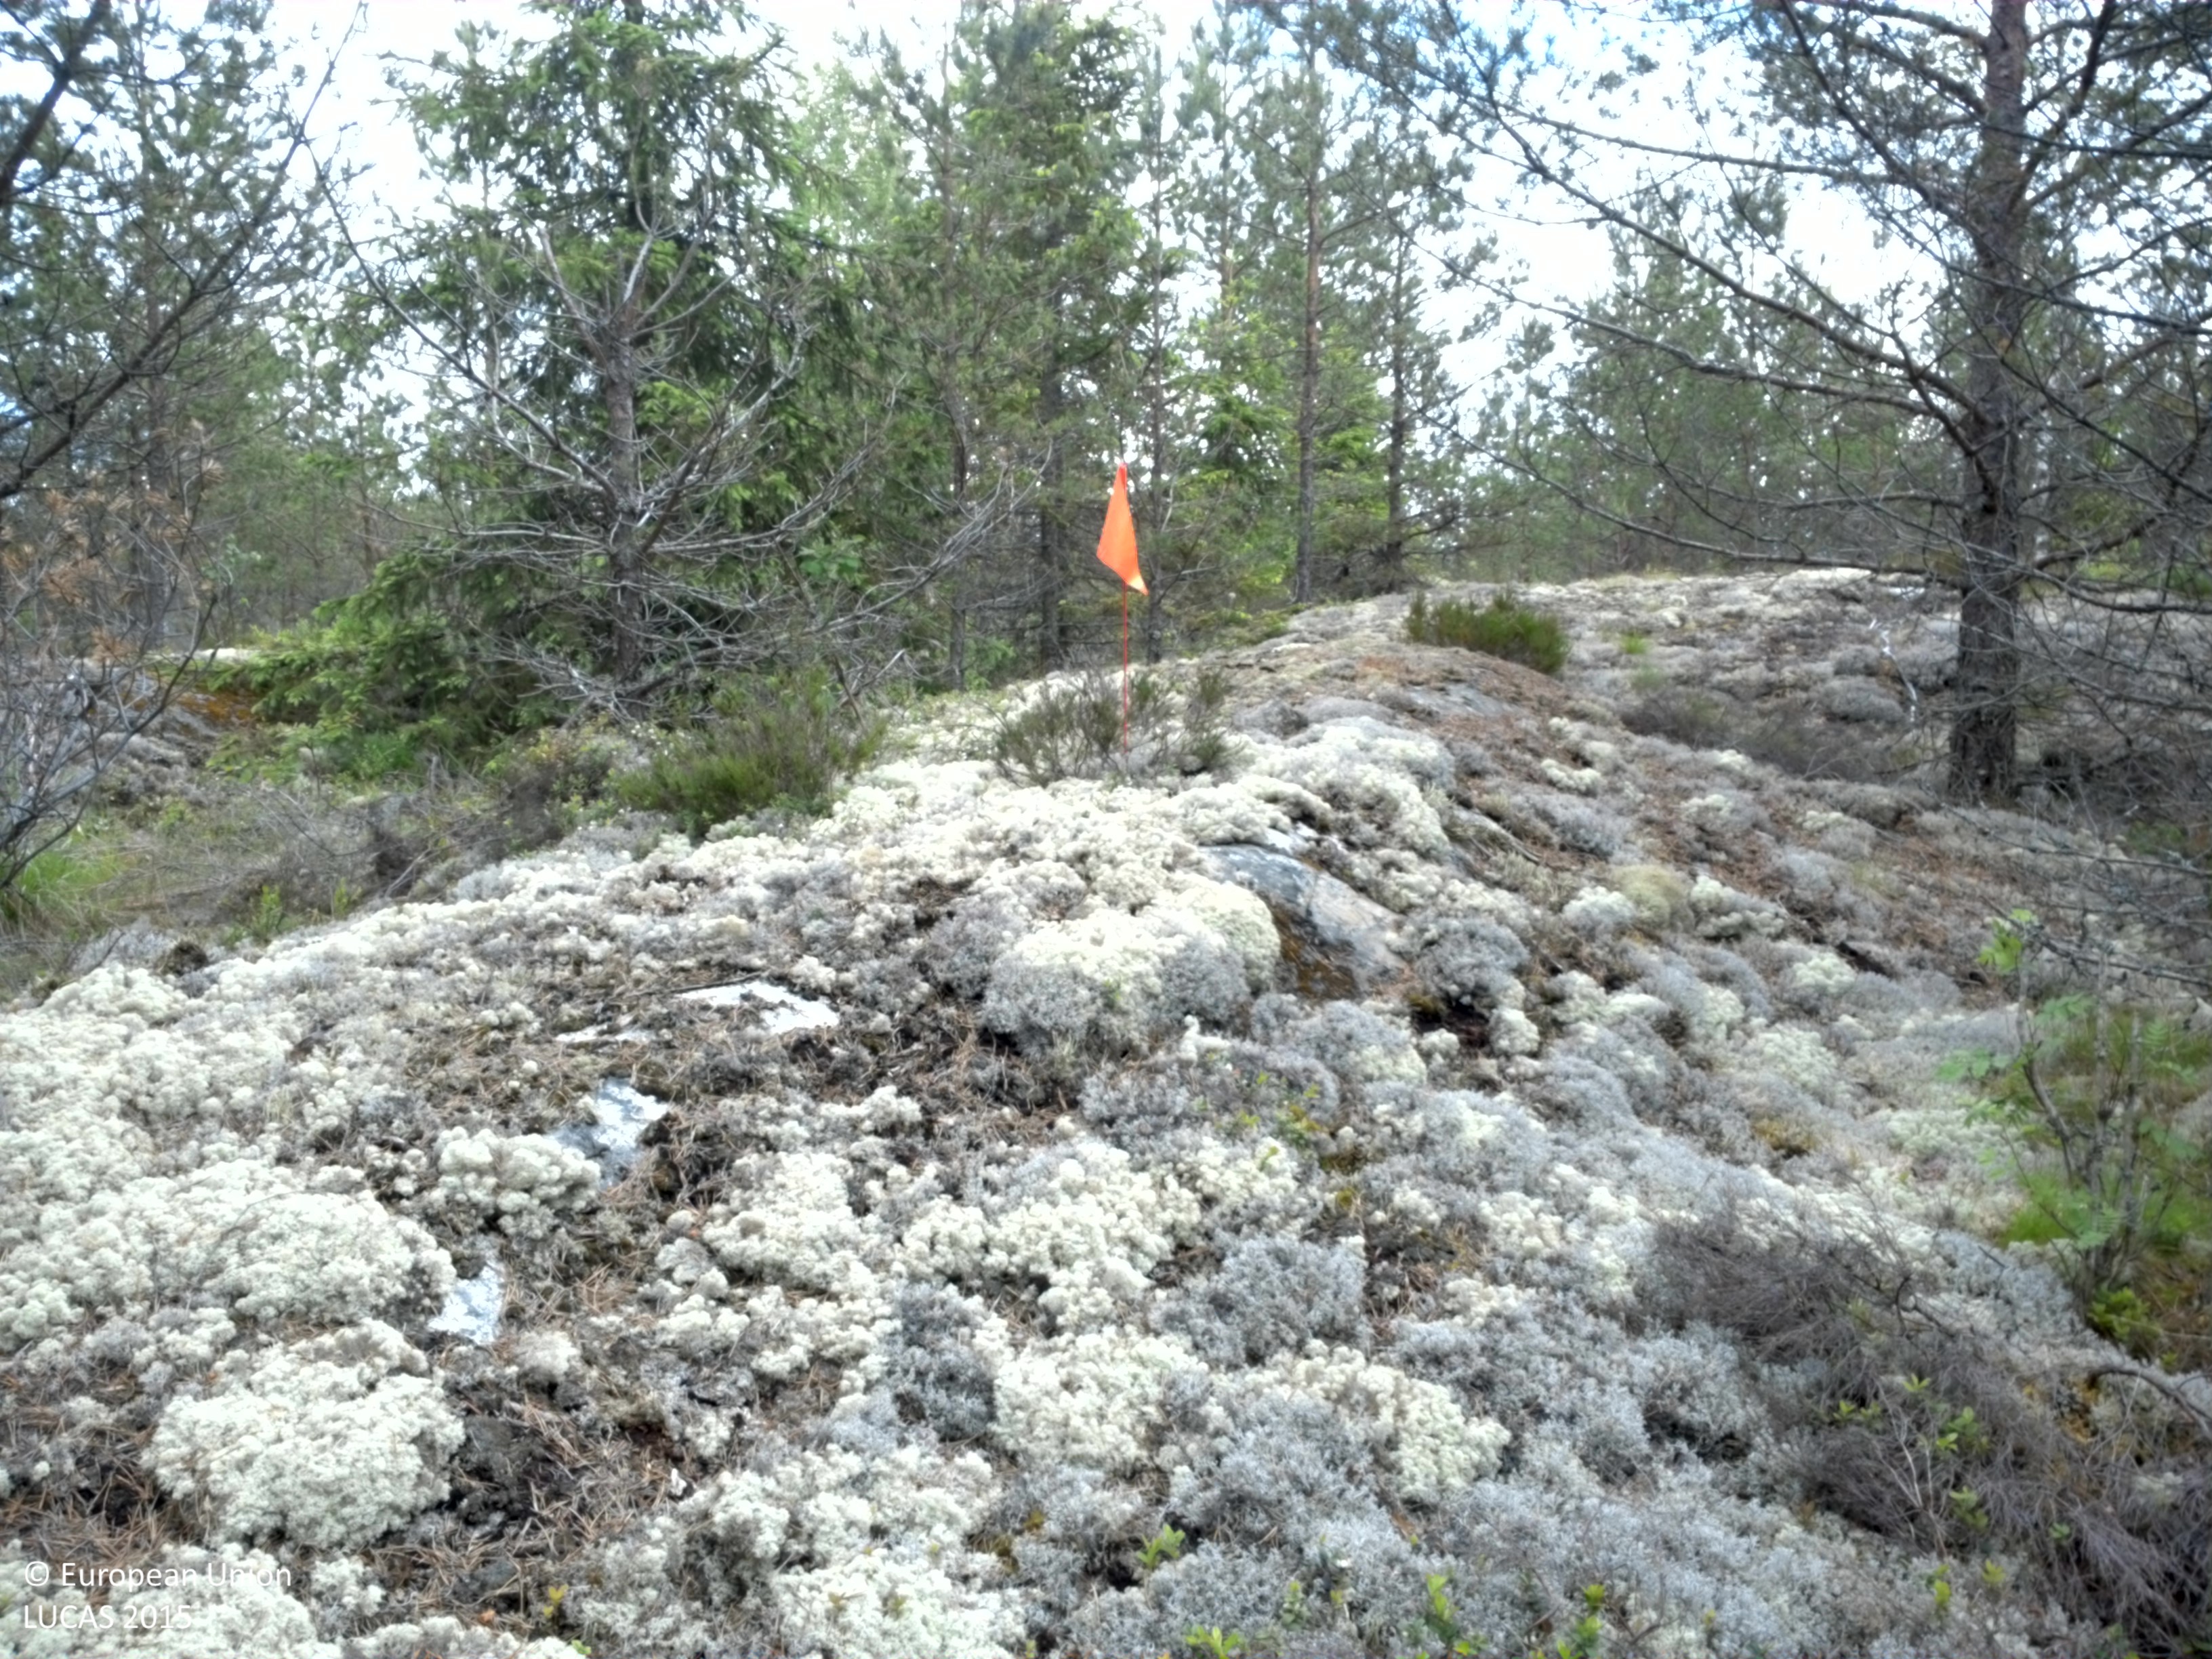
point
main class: Woodland
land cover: Pine dominated coniferous woodland
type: boreal forest
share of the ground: 25 - 50 %
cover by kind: coniferous forest trees 45 %, lichens and mosses 25 %, herbaceous plants 15 %, consolidated bare surface 10 %, broadleaved forest trees 5 %
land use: Forestry
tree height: > 5 m
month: June
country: SE
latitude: 59.9852
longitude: 17.0712
